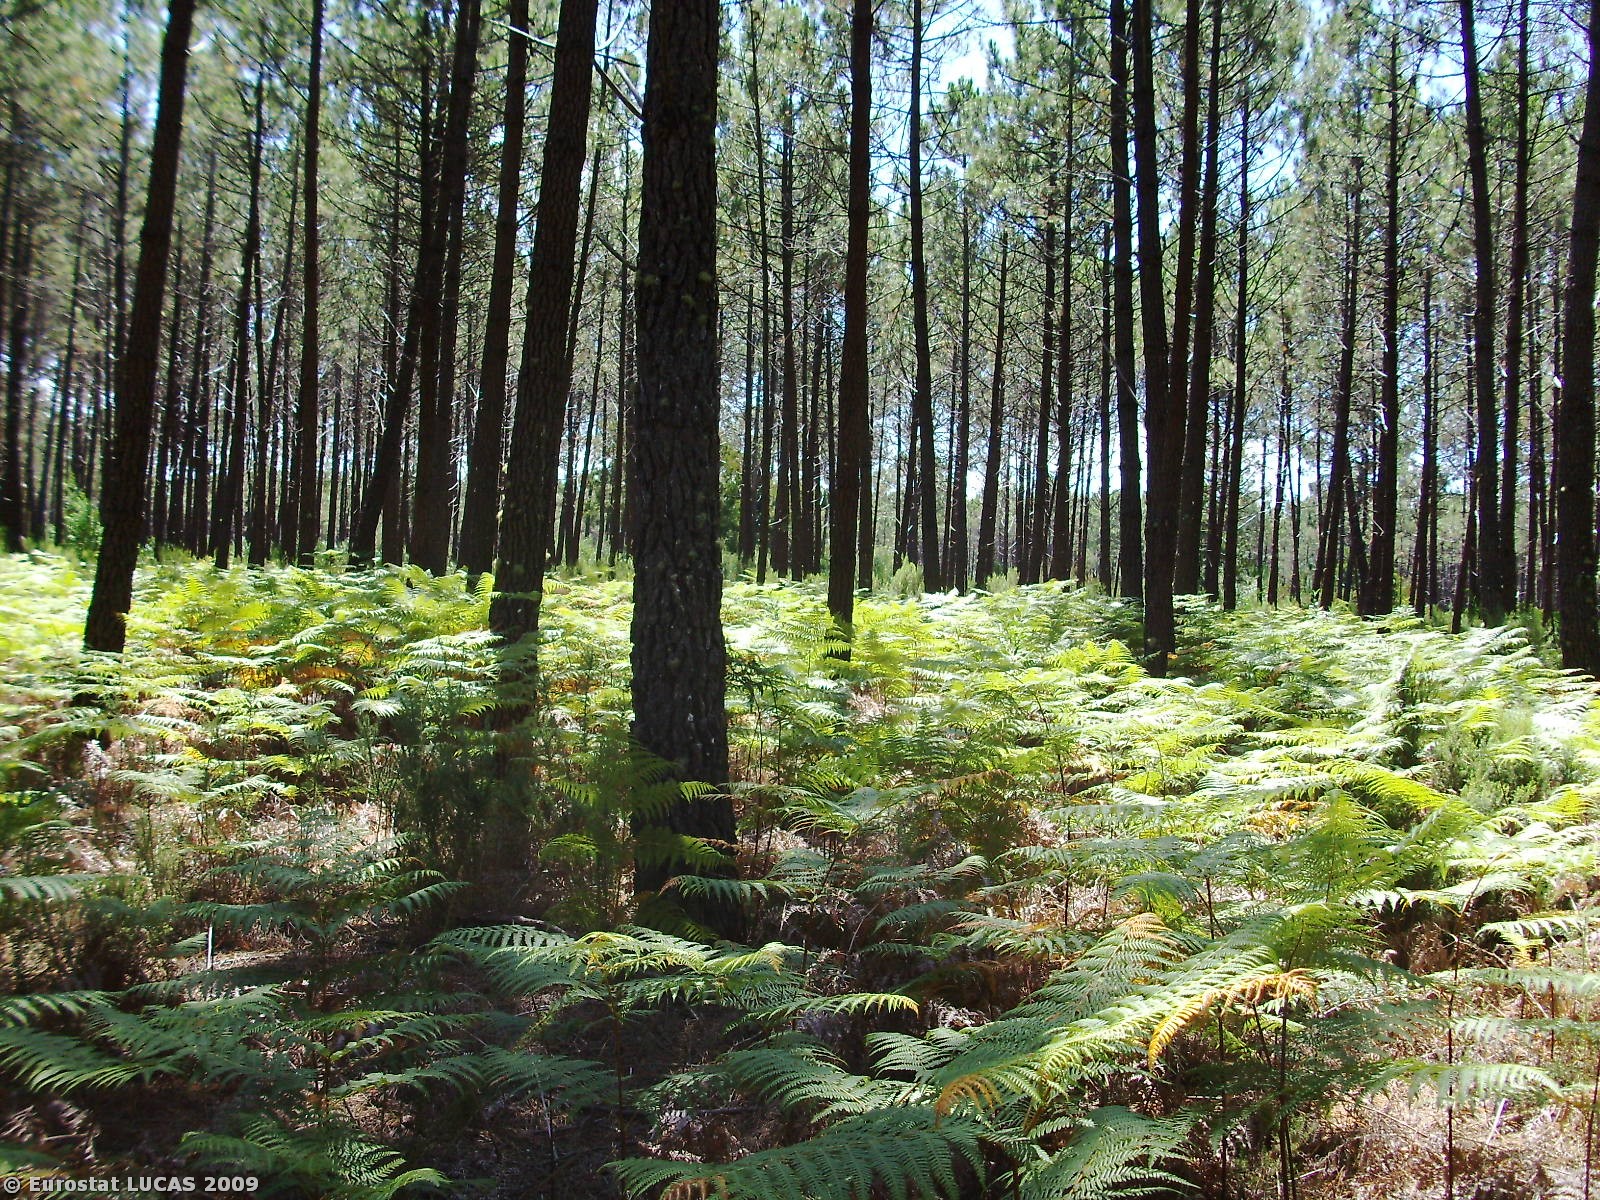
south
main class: Woodland
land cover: Coniferous woodland
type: coniferous forest of the mediterranean region
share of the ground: > 75 %
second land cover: Shrubland with sparse tree cover
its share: 10 - 25 %
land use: Forestry
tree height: > 5 m
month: July
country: PT
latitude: 39.8343
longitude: -8.9154
